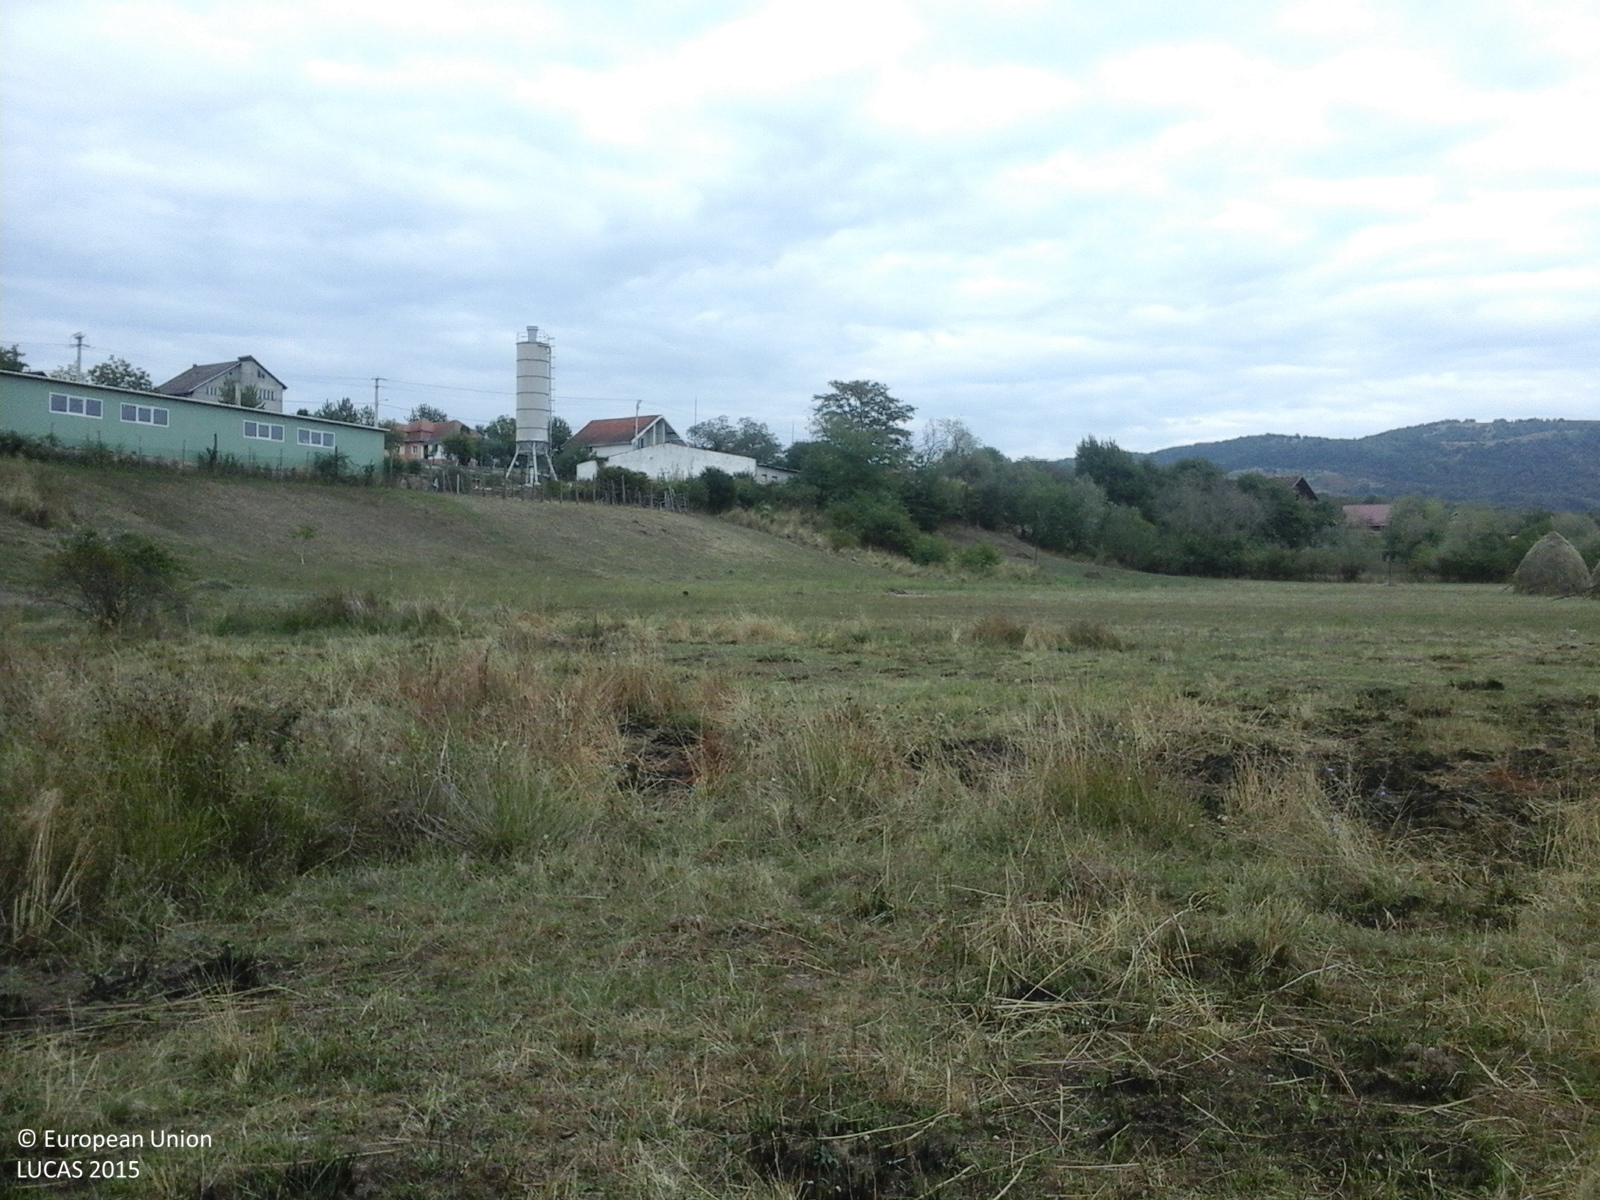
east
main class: Grassland
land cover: Grassland without tree/shrub cover
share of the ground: > 75 %
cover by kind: herbaceous plants 100 %
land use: Agriculture (excluding fallow land and kitchen gardens)
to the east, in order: Grassland without tree/shrub cover; Spontaneously vegetated surfaces; Grassland without tree/shrub cover; Abandoned hedges; Grassland without tree/shrub cover; Artificial constructions in urban areas; Grassland without tree/shrub cover; Abandoned hedges; Paved roads, cycling and walking lanes
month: September
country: RO
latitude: 47.8536
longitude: 23.4260
